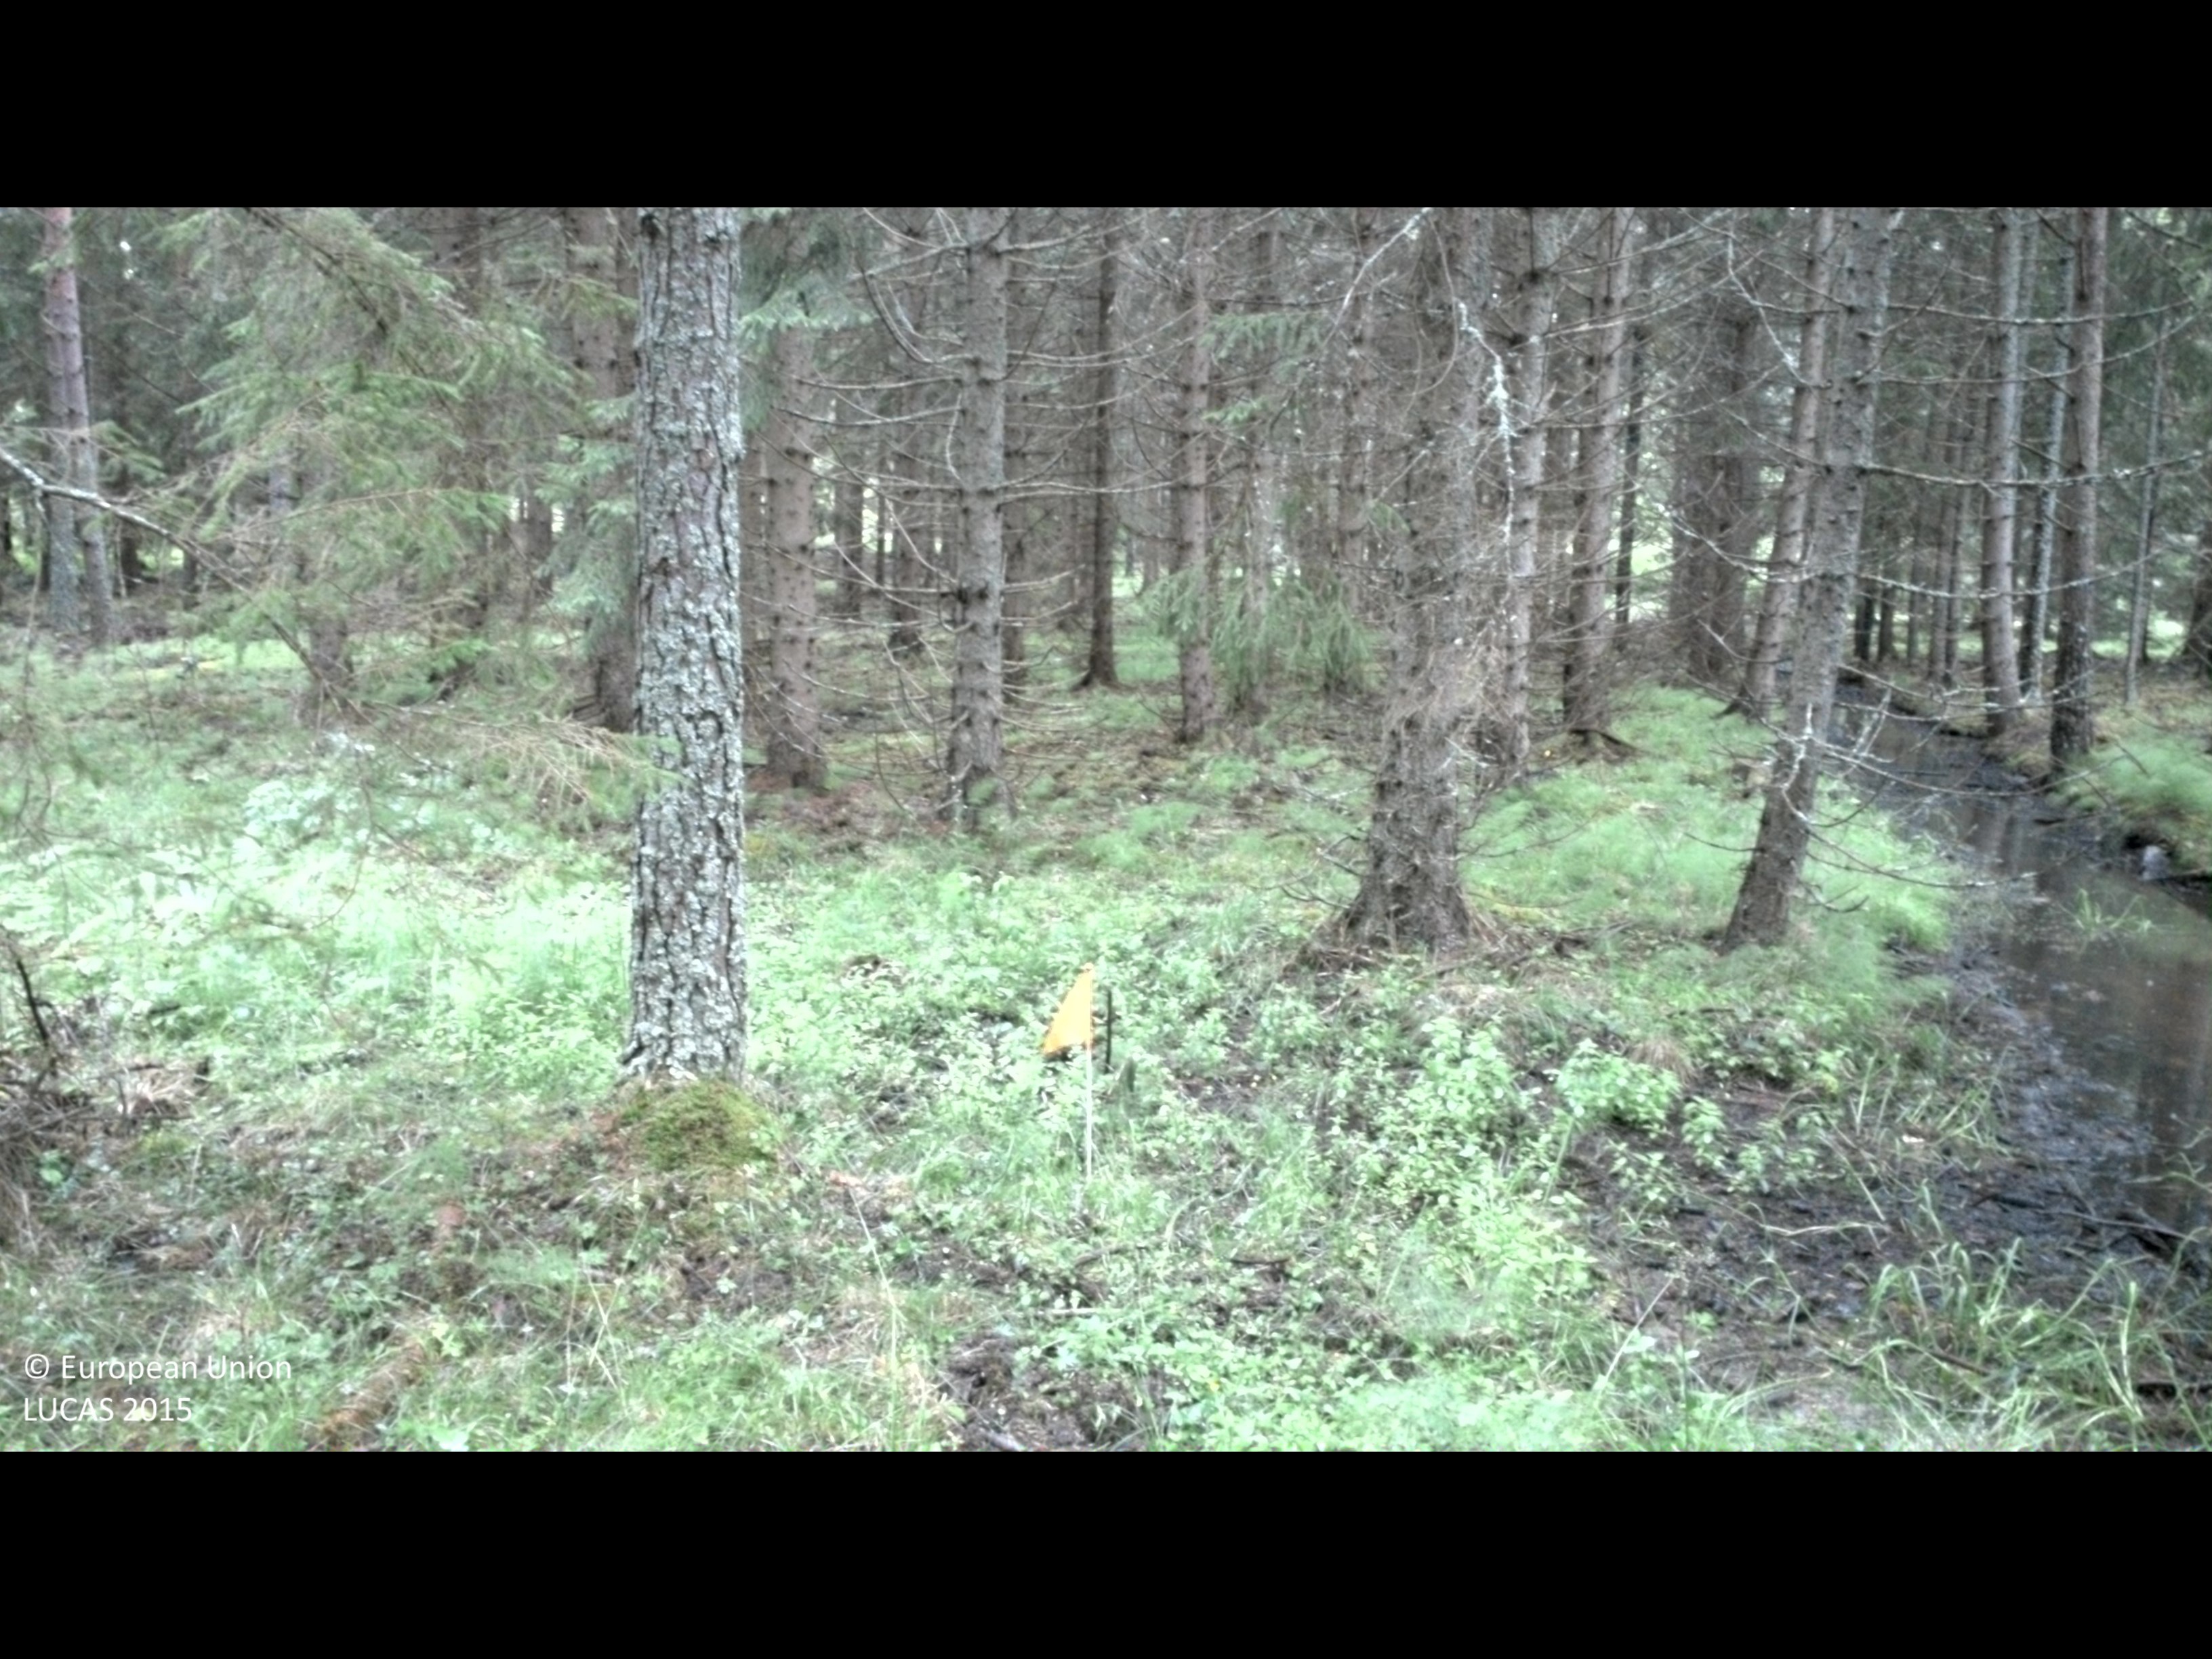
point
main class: Woodland
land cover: Spruce dominated coniferous woodland
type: boreal forest
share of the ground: 50 - 75 %
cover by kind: coniferous forest trees 60 %, herbaceous plants 20 %, lichens and mosses 15 %, shrubs 5 %
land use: Forestry
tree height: > 5 m
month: July
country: SE
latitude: 58.3488
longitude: 16.1638
